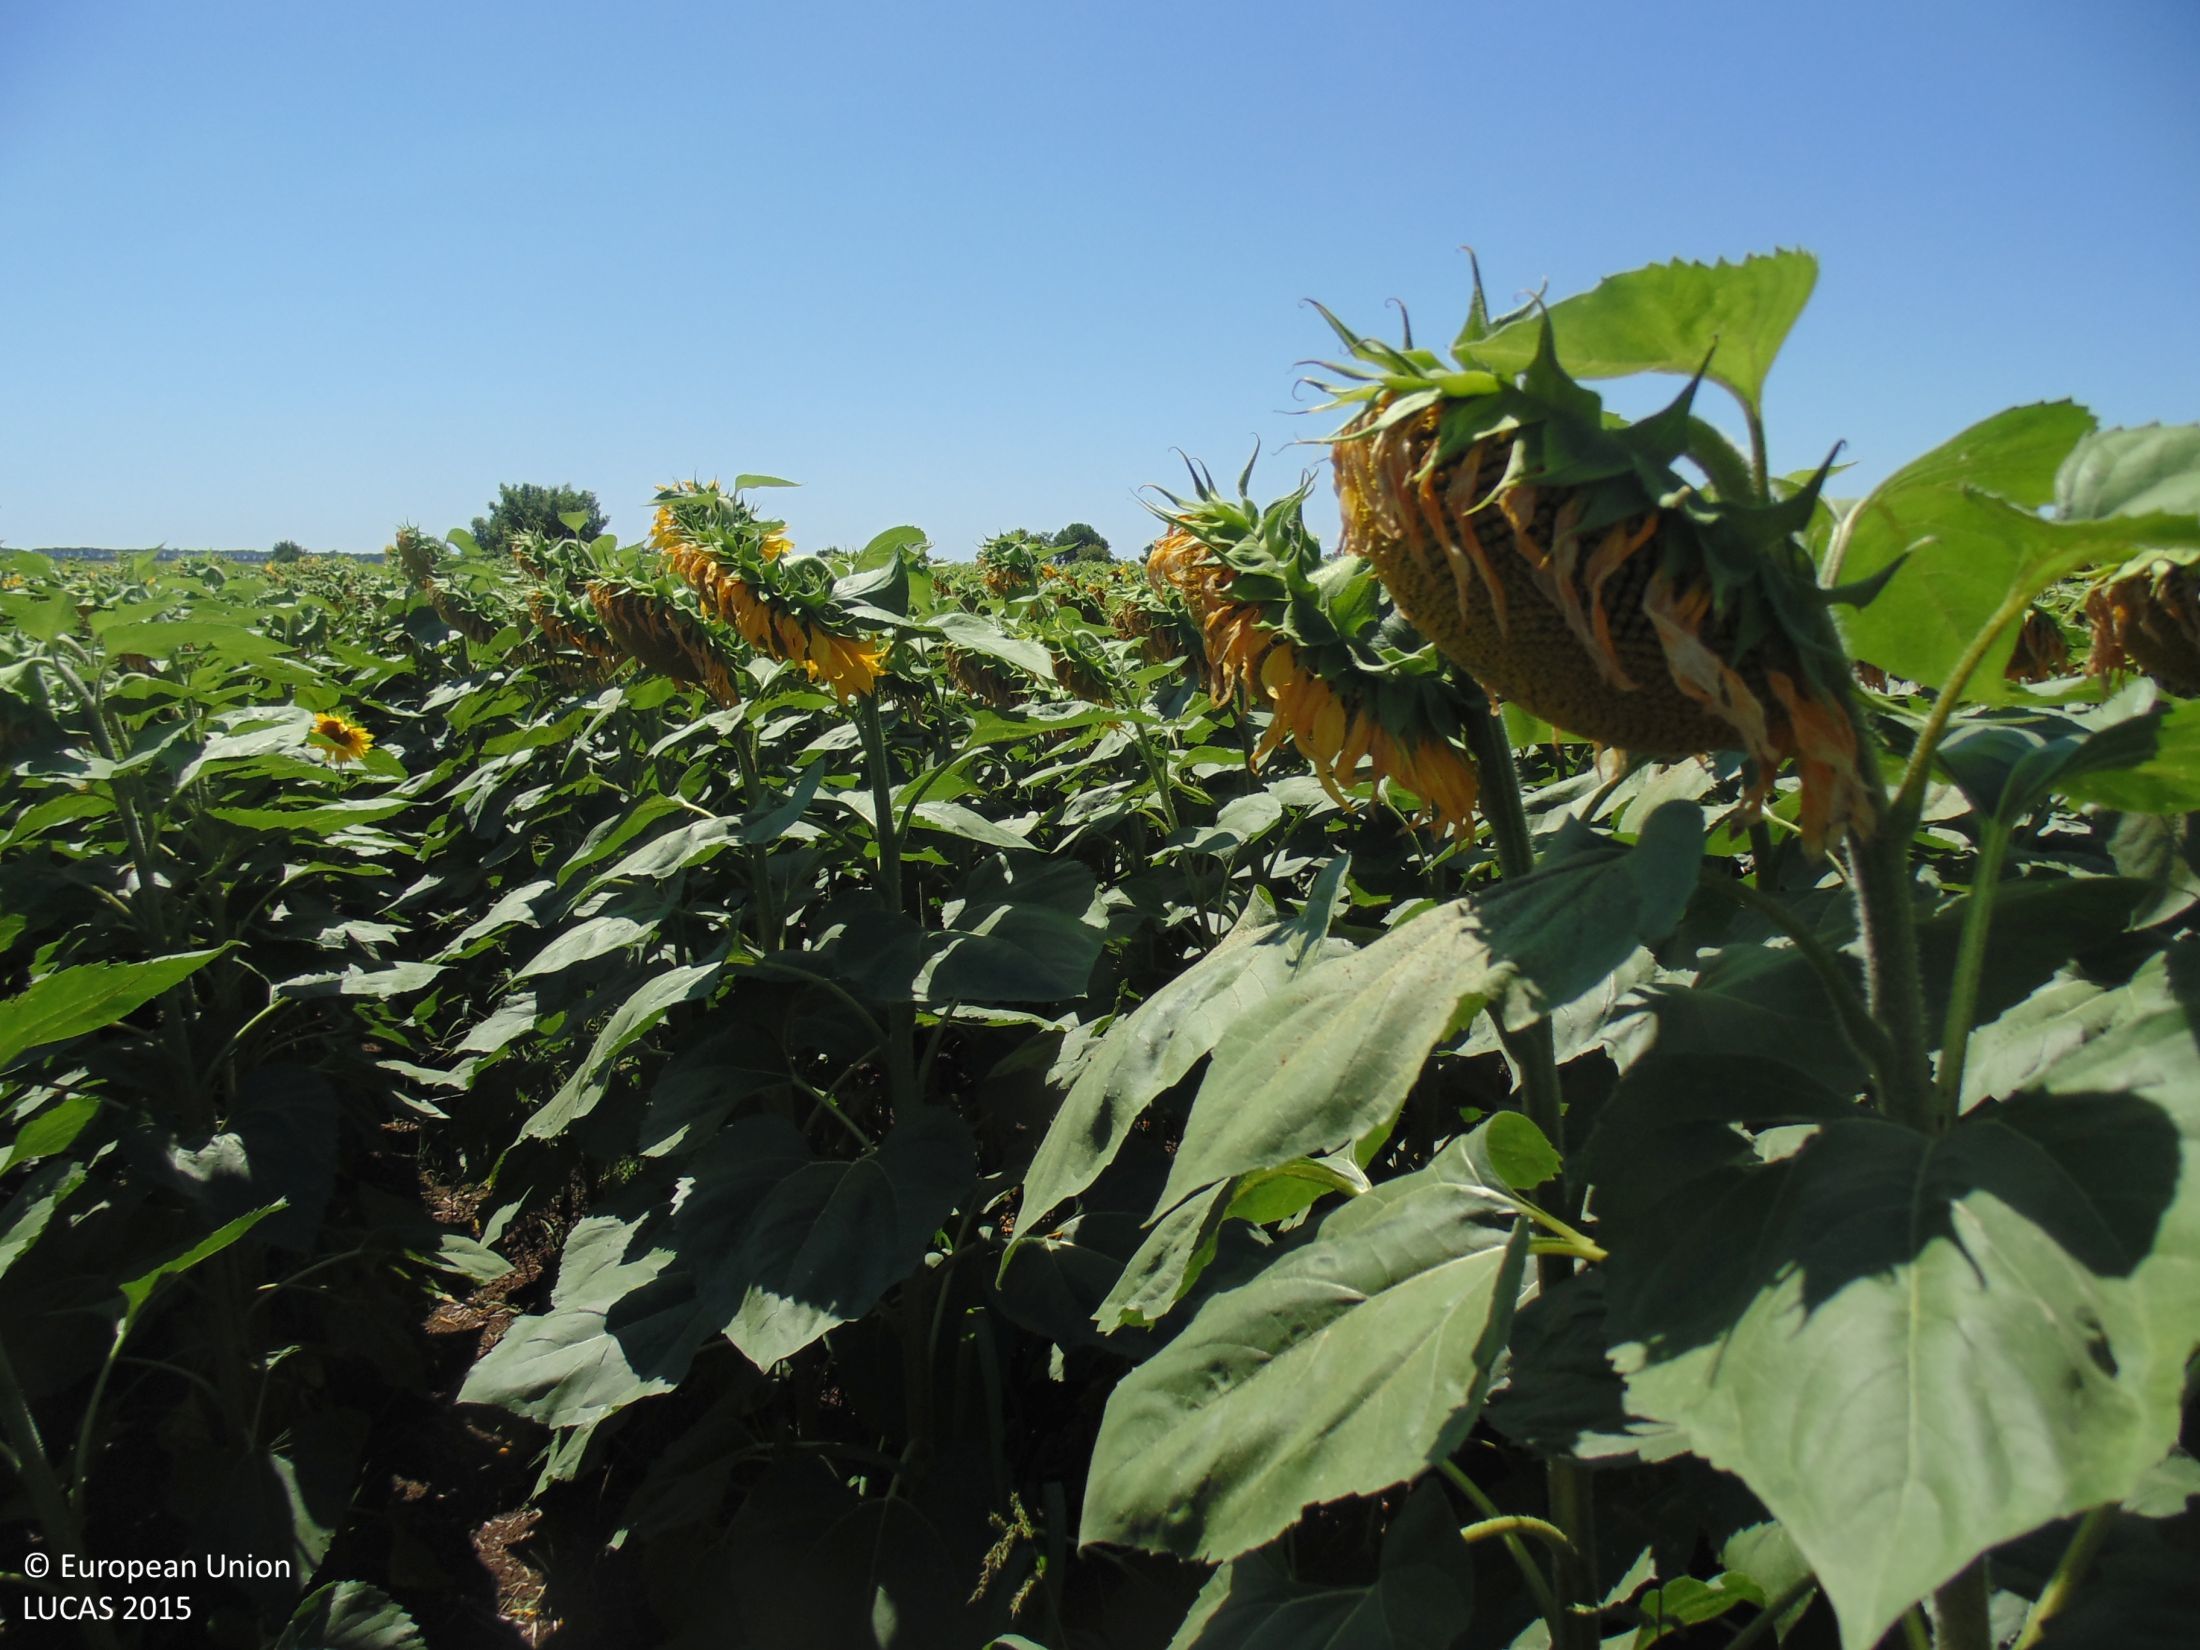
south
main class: Cropland
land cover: Sunflower
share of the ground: > 75 %
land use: Agriculture (excluding fallow land and kitchen gardens)
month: July
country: BG
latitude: 43.4478
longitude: 28.1789
